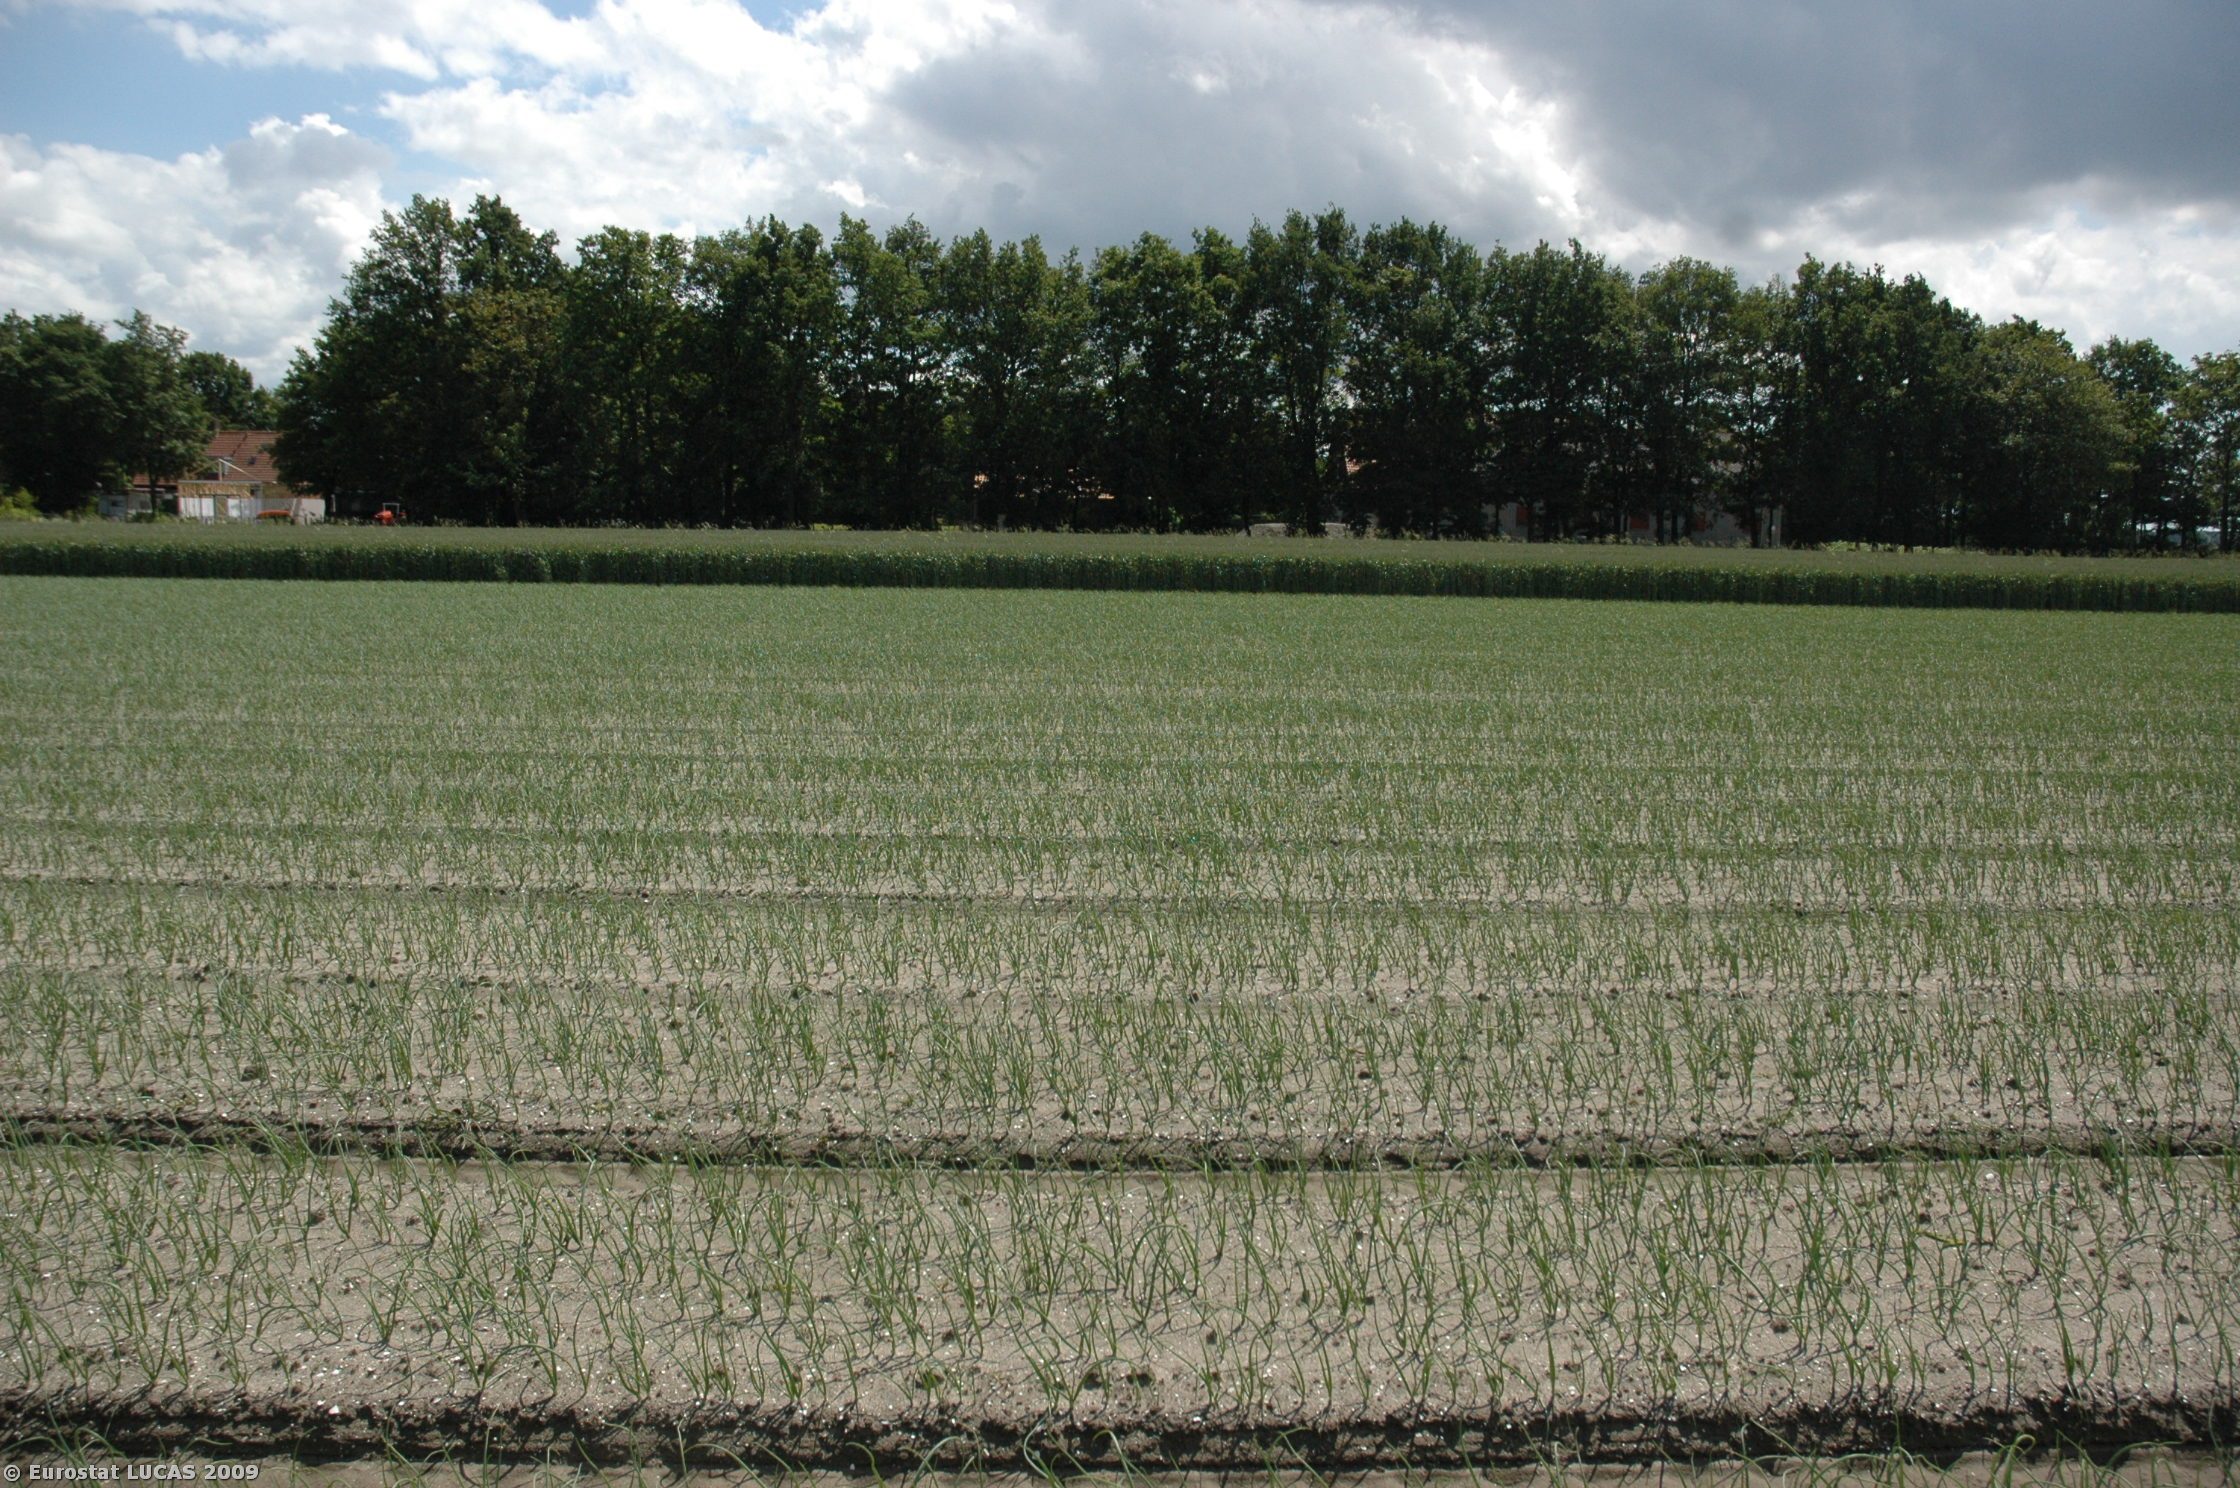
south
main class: Cropland
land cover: Other fresh vegetables
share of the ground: > 75 %
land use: Agriculture (excluding fallow land and kitchen gardens)
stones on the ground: < 10 %
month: June
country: NL
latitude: 52.7112
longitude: 5.6322
